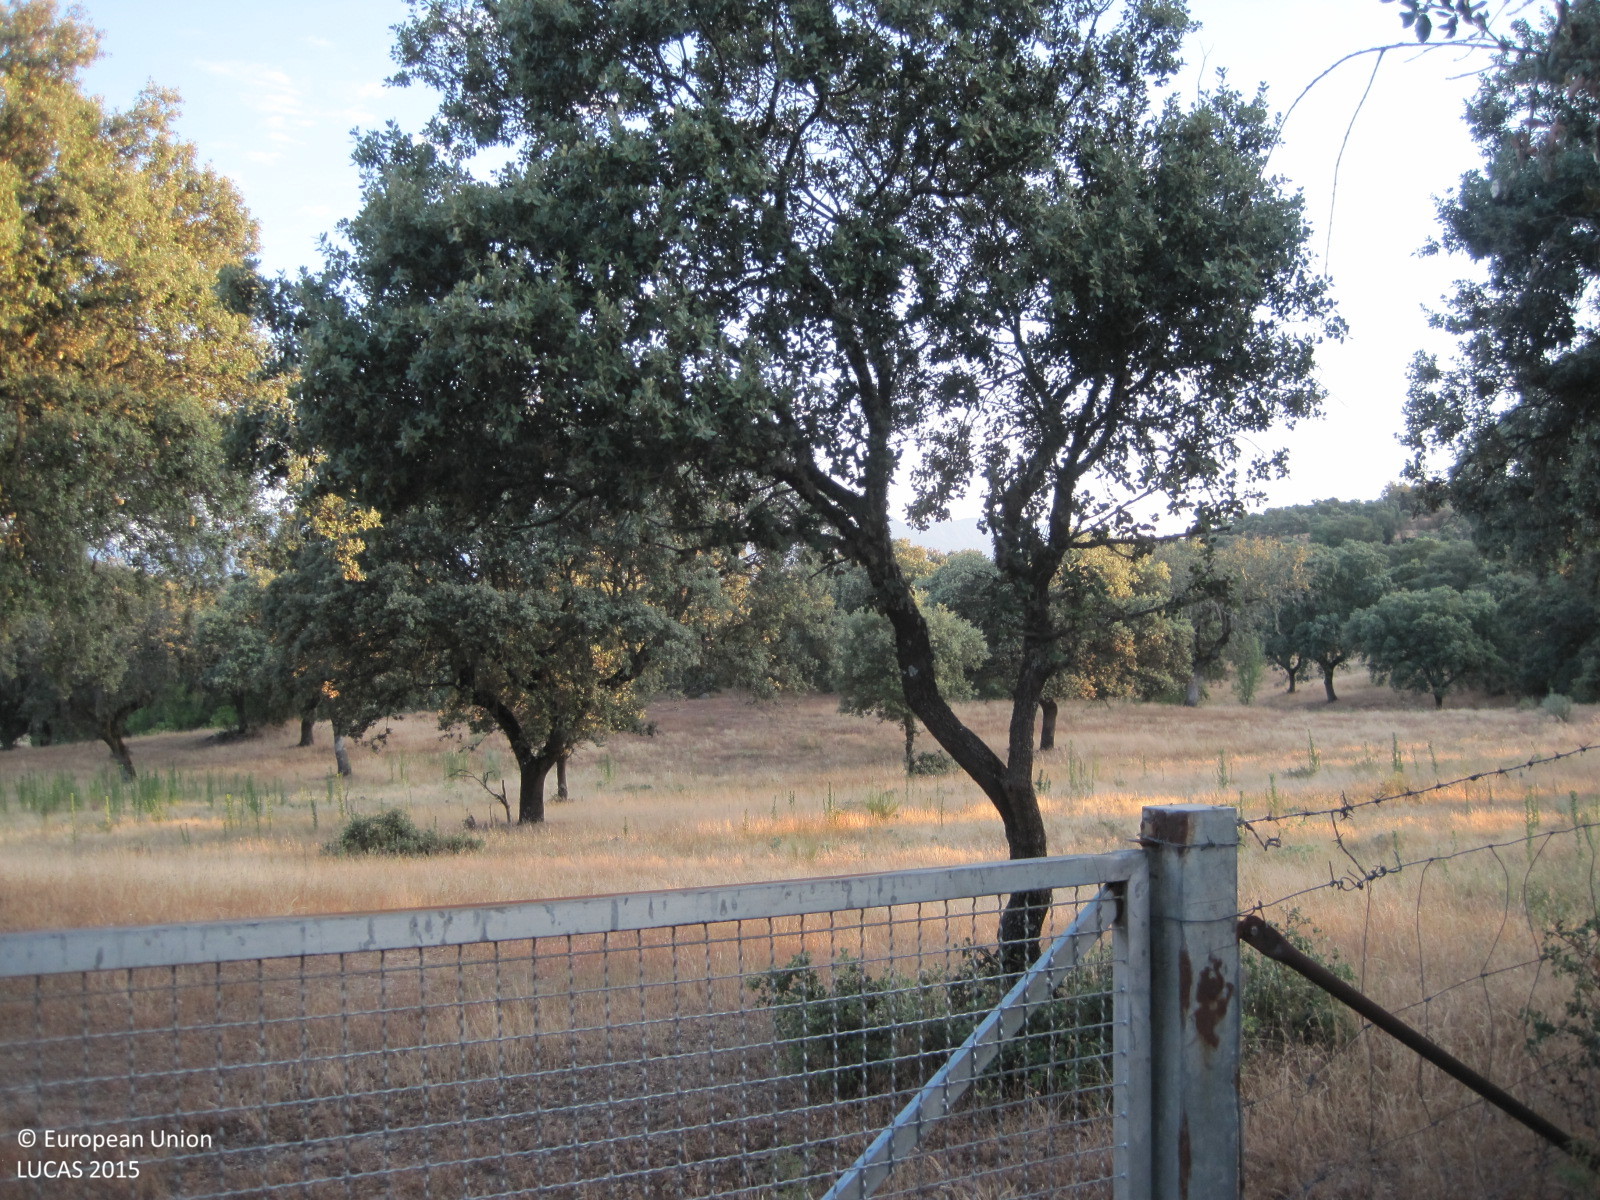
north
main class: Woodland
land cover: Broadleaved woodland
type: broadleaved evergreen forest
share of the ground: 25 - 50 %
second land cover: Grassland without tree/shrub cover
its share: > 75 %
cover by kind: herbaceous plants 60 %, broadleaved forest trees 25 %, unconsolidated bare surface 15 %
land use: Forestry
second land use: Agriculture (excluding fallow land and kitchen gardens)
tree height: > 5 m
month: June
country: ES
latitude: 40.0757
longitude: -5.1464
